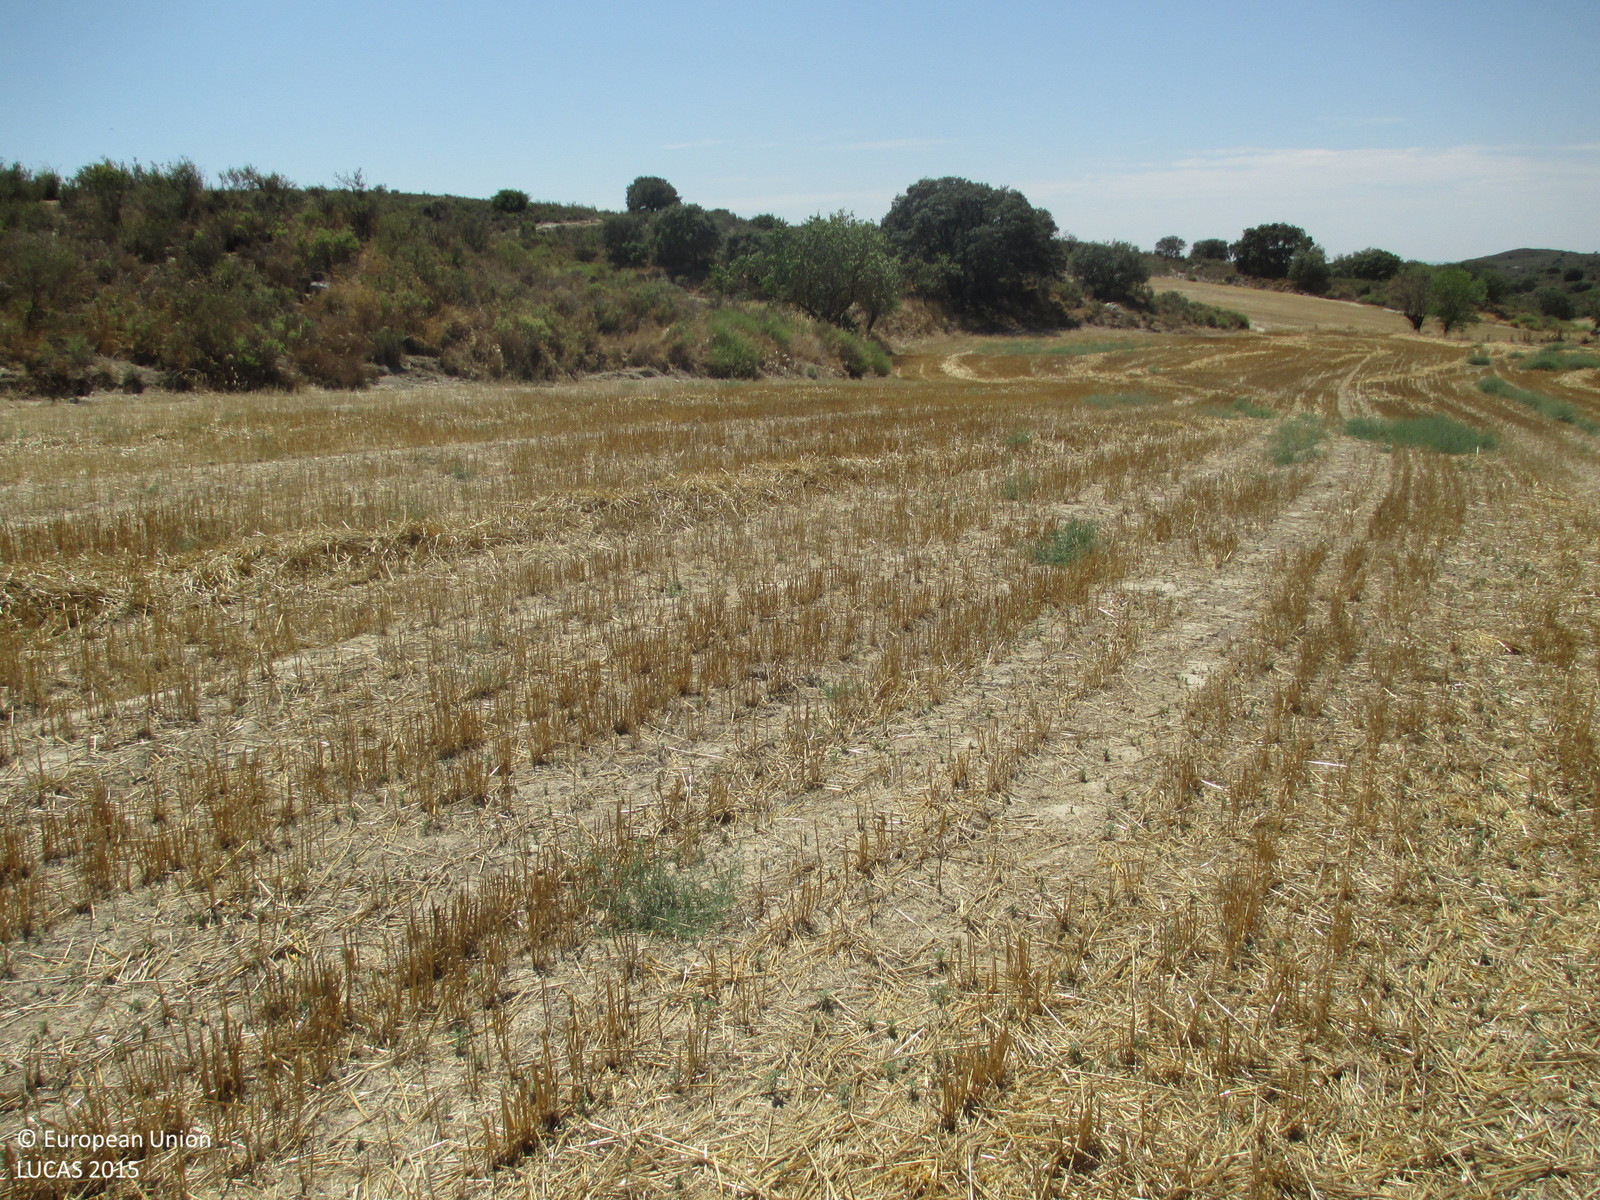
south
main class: Cropland
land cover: Barley
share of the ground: < 10 %
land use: Agriculture (excluding fallow land and kitchen gardens)
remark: Harvested field
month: July
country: ES
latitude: 41.9484
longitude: 0.2725
